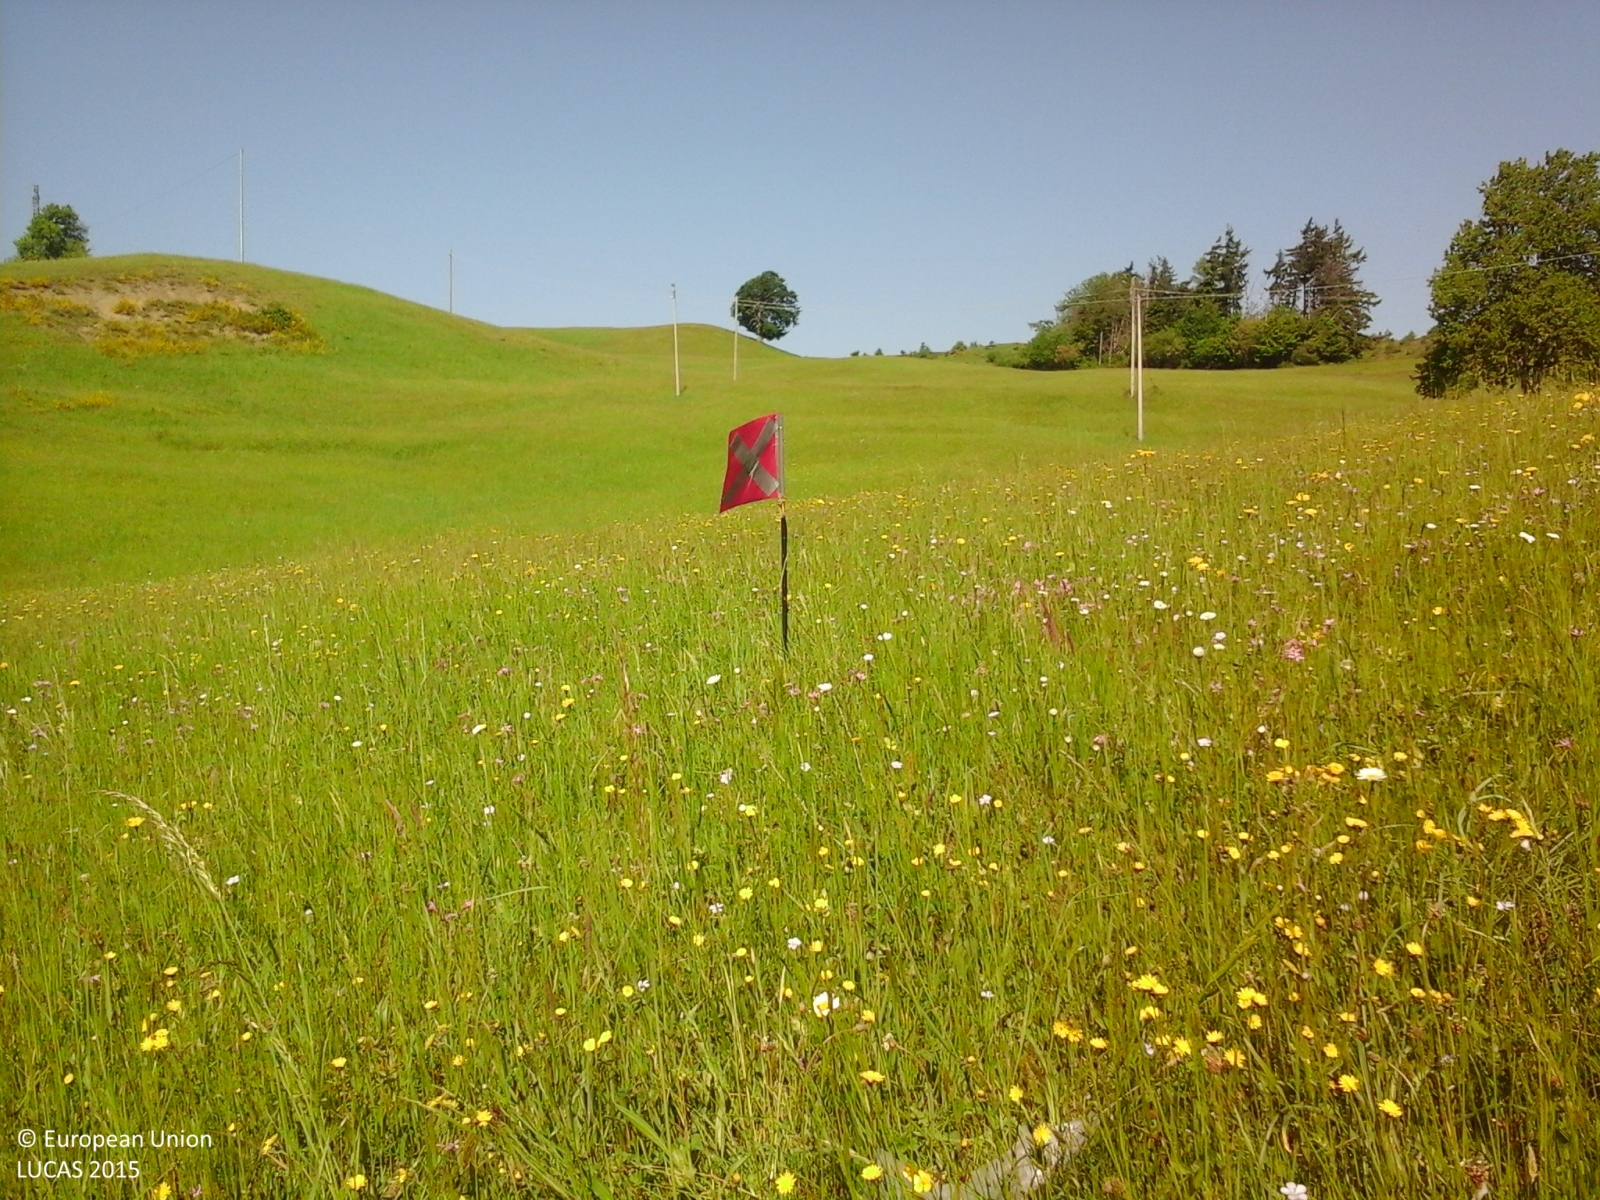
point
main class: Grassland
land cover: Grassland without tree/shrub cover
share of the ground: > 75 %
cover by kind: herbaceous plants 100 %
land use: Agriculture (excluding fallow land and kitchen gardens)
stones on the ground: < 10 %
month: May
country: IT
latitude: 44.1281
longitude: 11.1096
